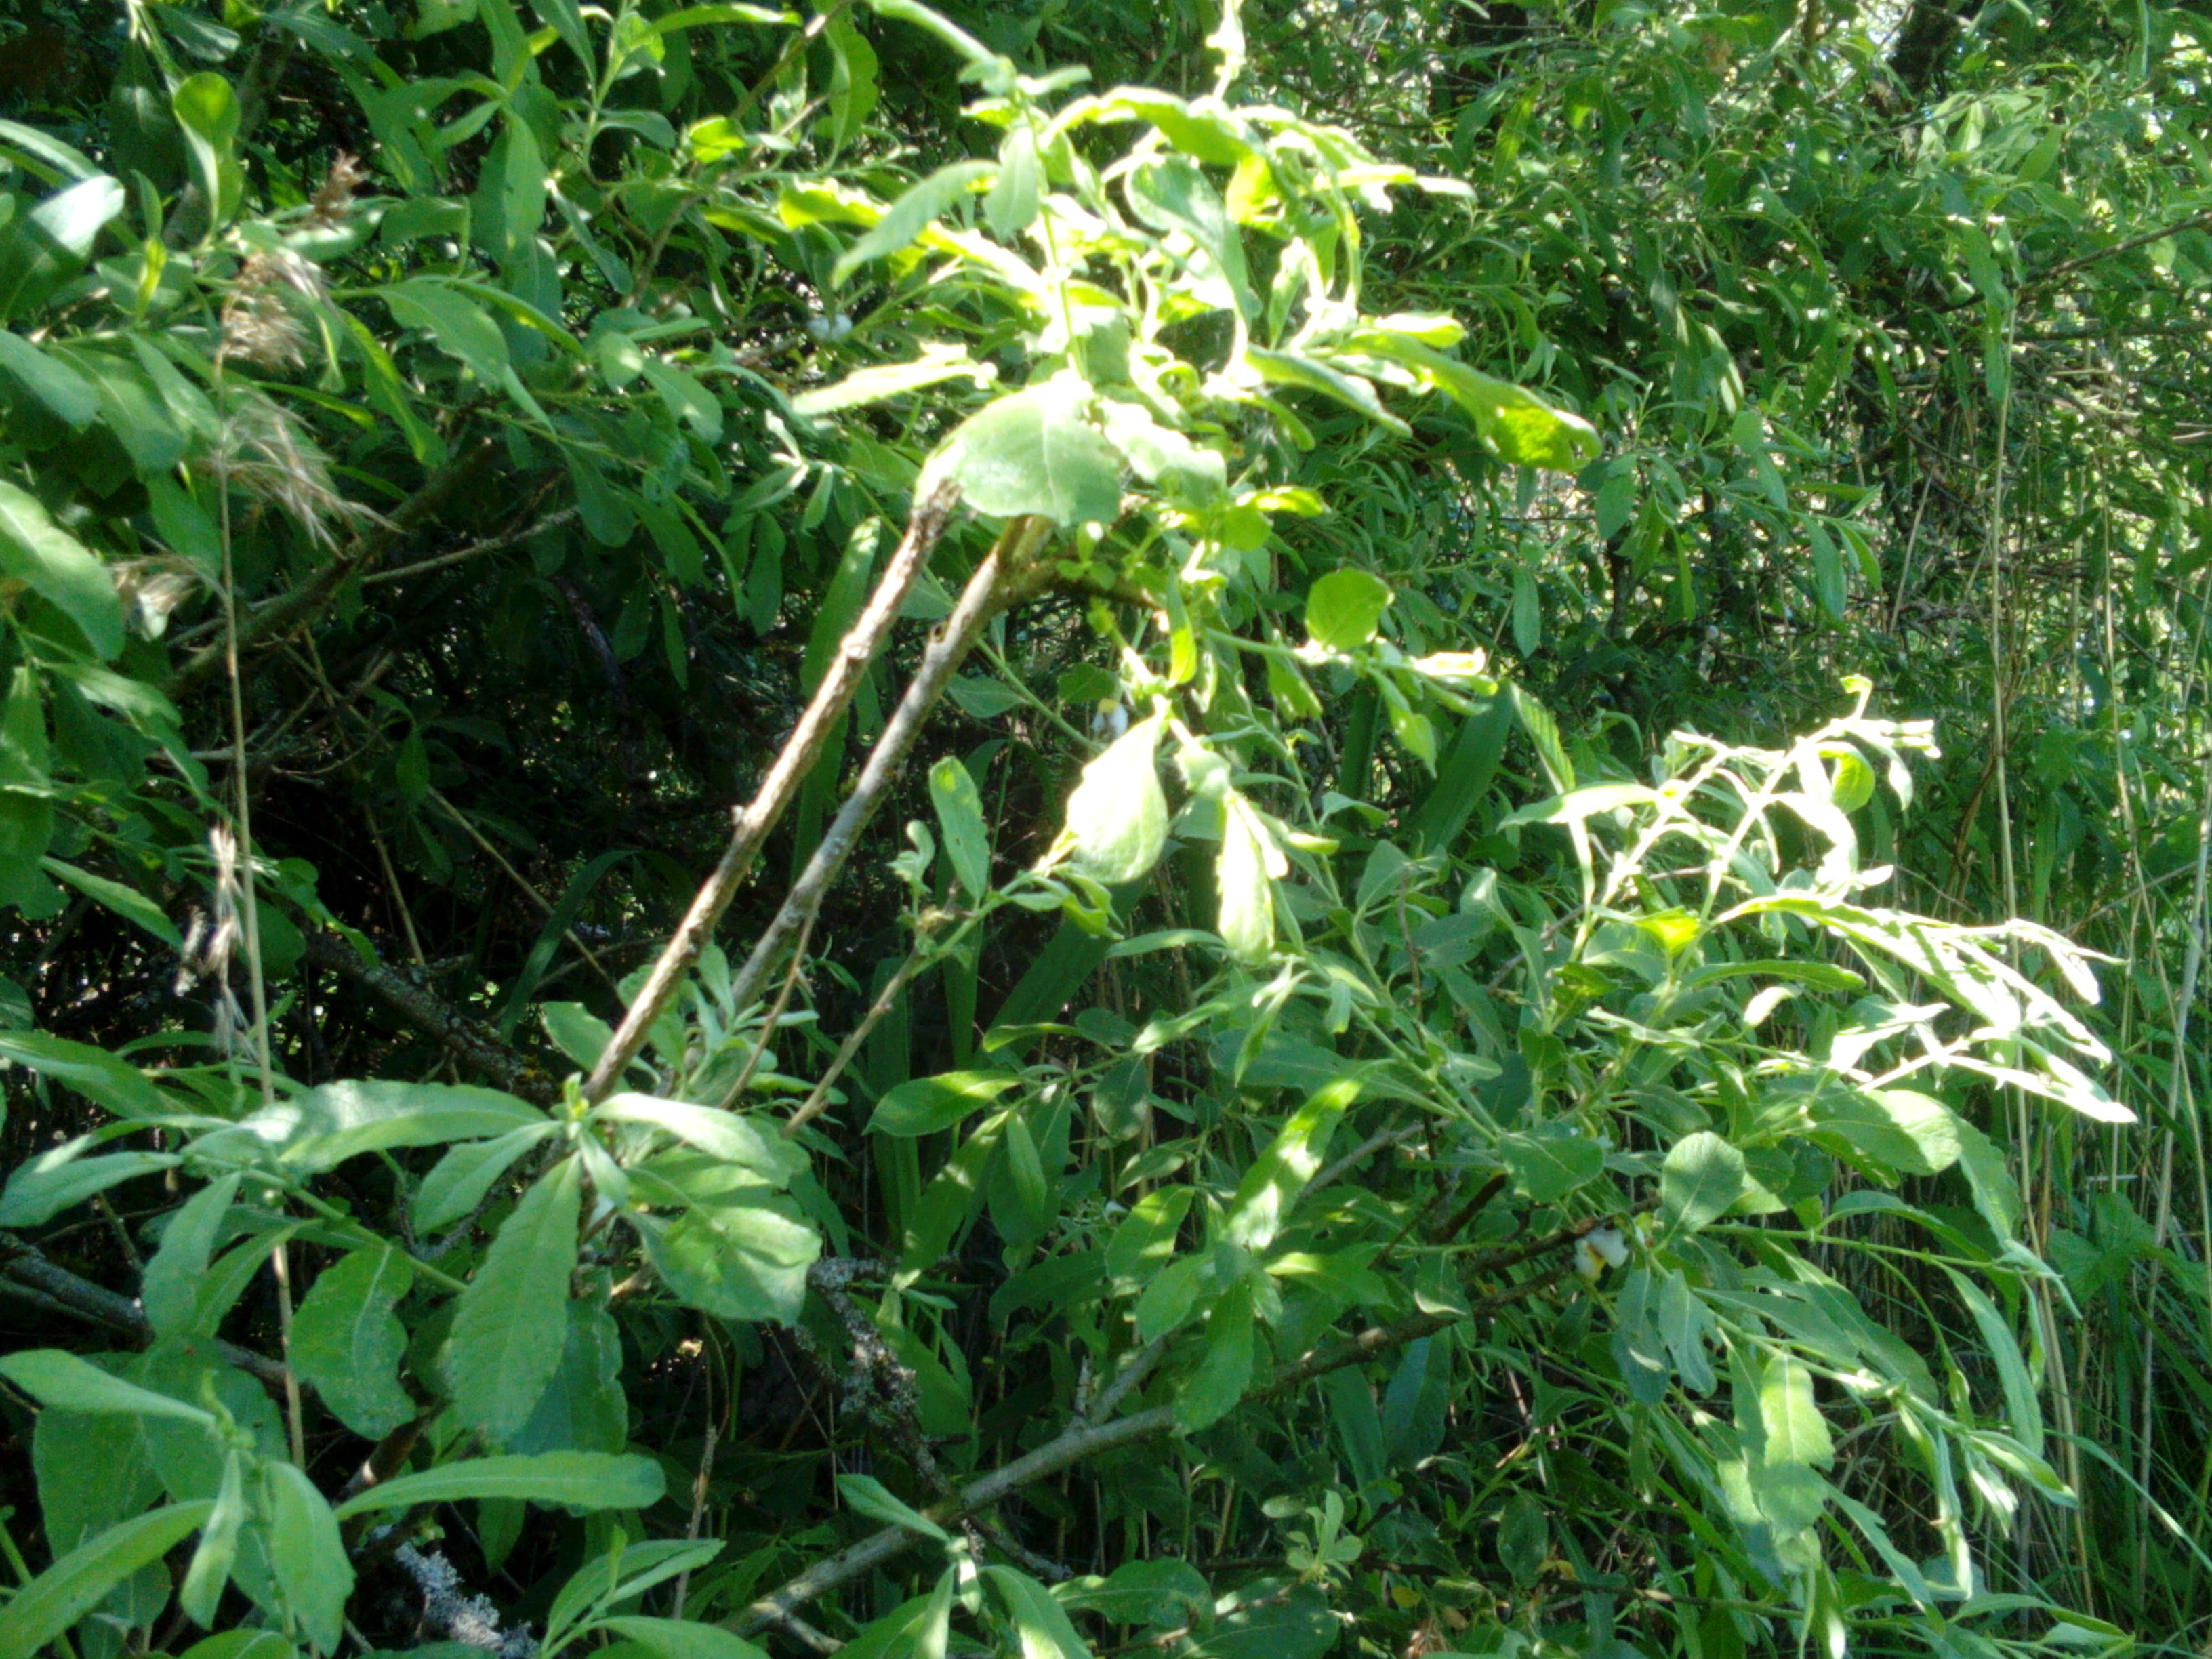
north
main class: Woodland
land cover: Broadleaved woodland
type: non-riverine alder, birch or aspen forest
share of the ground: > 75 %
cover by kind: broadleaved forest trees 65 %, coniferous forest trees 20 %, shrubs 10 %, herbaceous plants 5 %
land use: Forestry
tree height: > 5 m
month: June
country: LV
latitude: 56.5849
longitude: 22.2148
